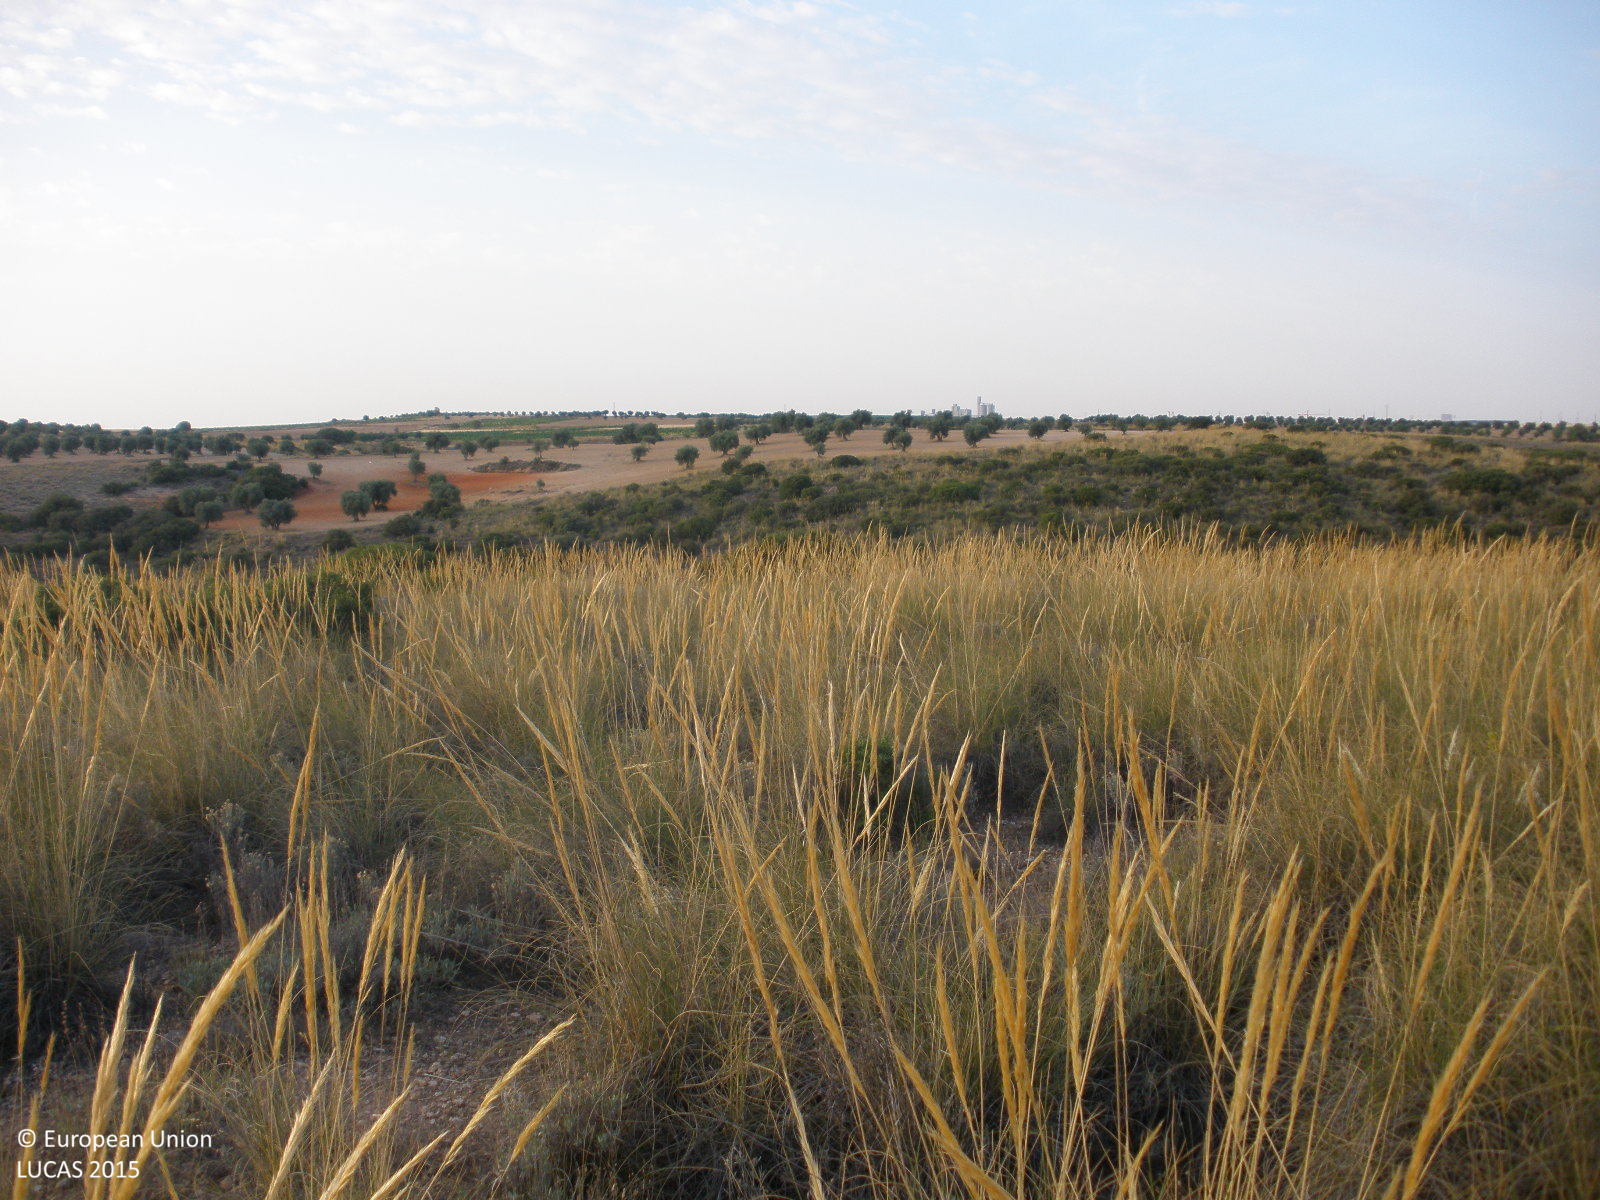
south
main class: Shrubland
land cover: Shrubland without tree cover
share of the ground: 25 - 50 %
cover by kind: herbaceous plants 50 %, shrubs 40 %, consolidated bare surface 10 %
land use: Semi-natural and natural areas not in use
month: July
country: ES
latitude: 40.0004
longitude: -3.4168
